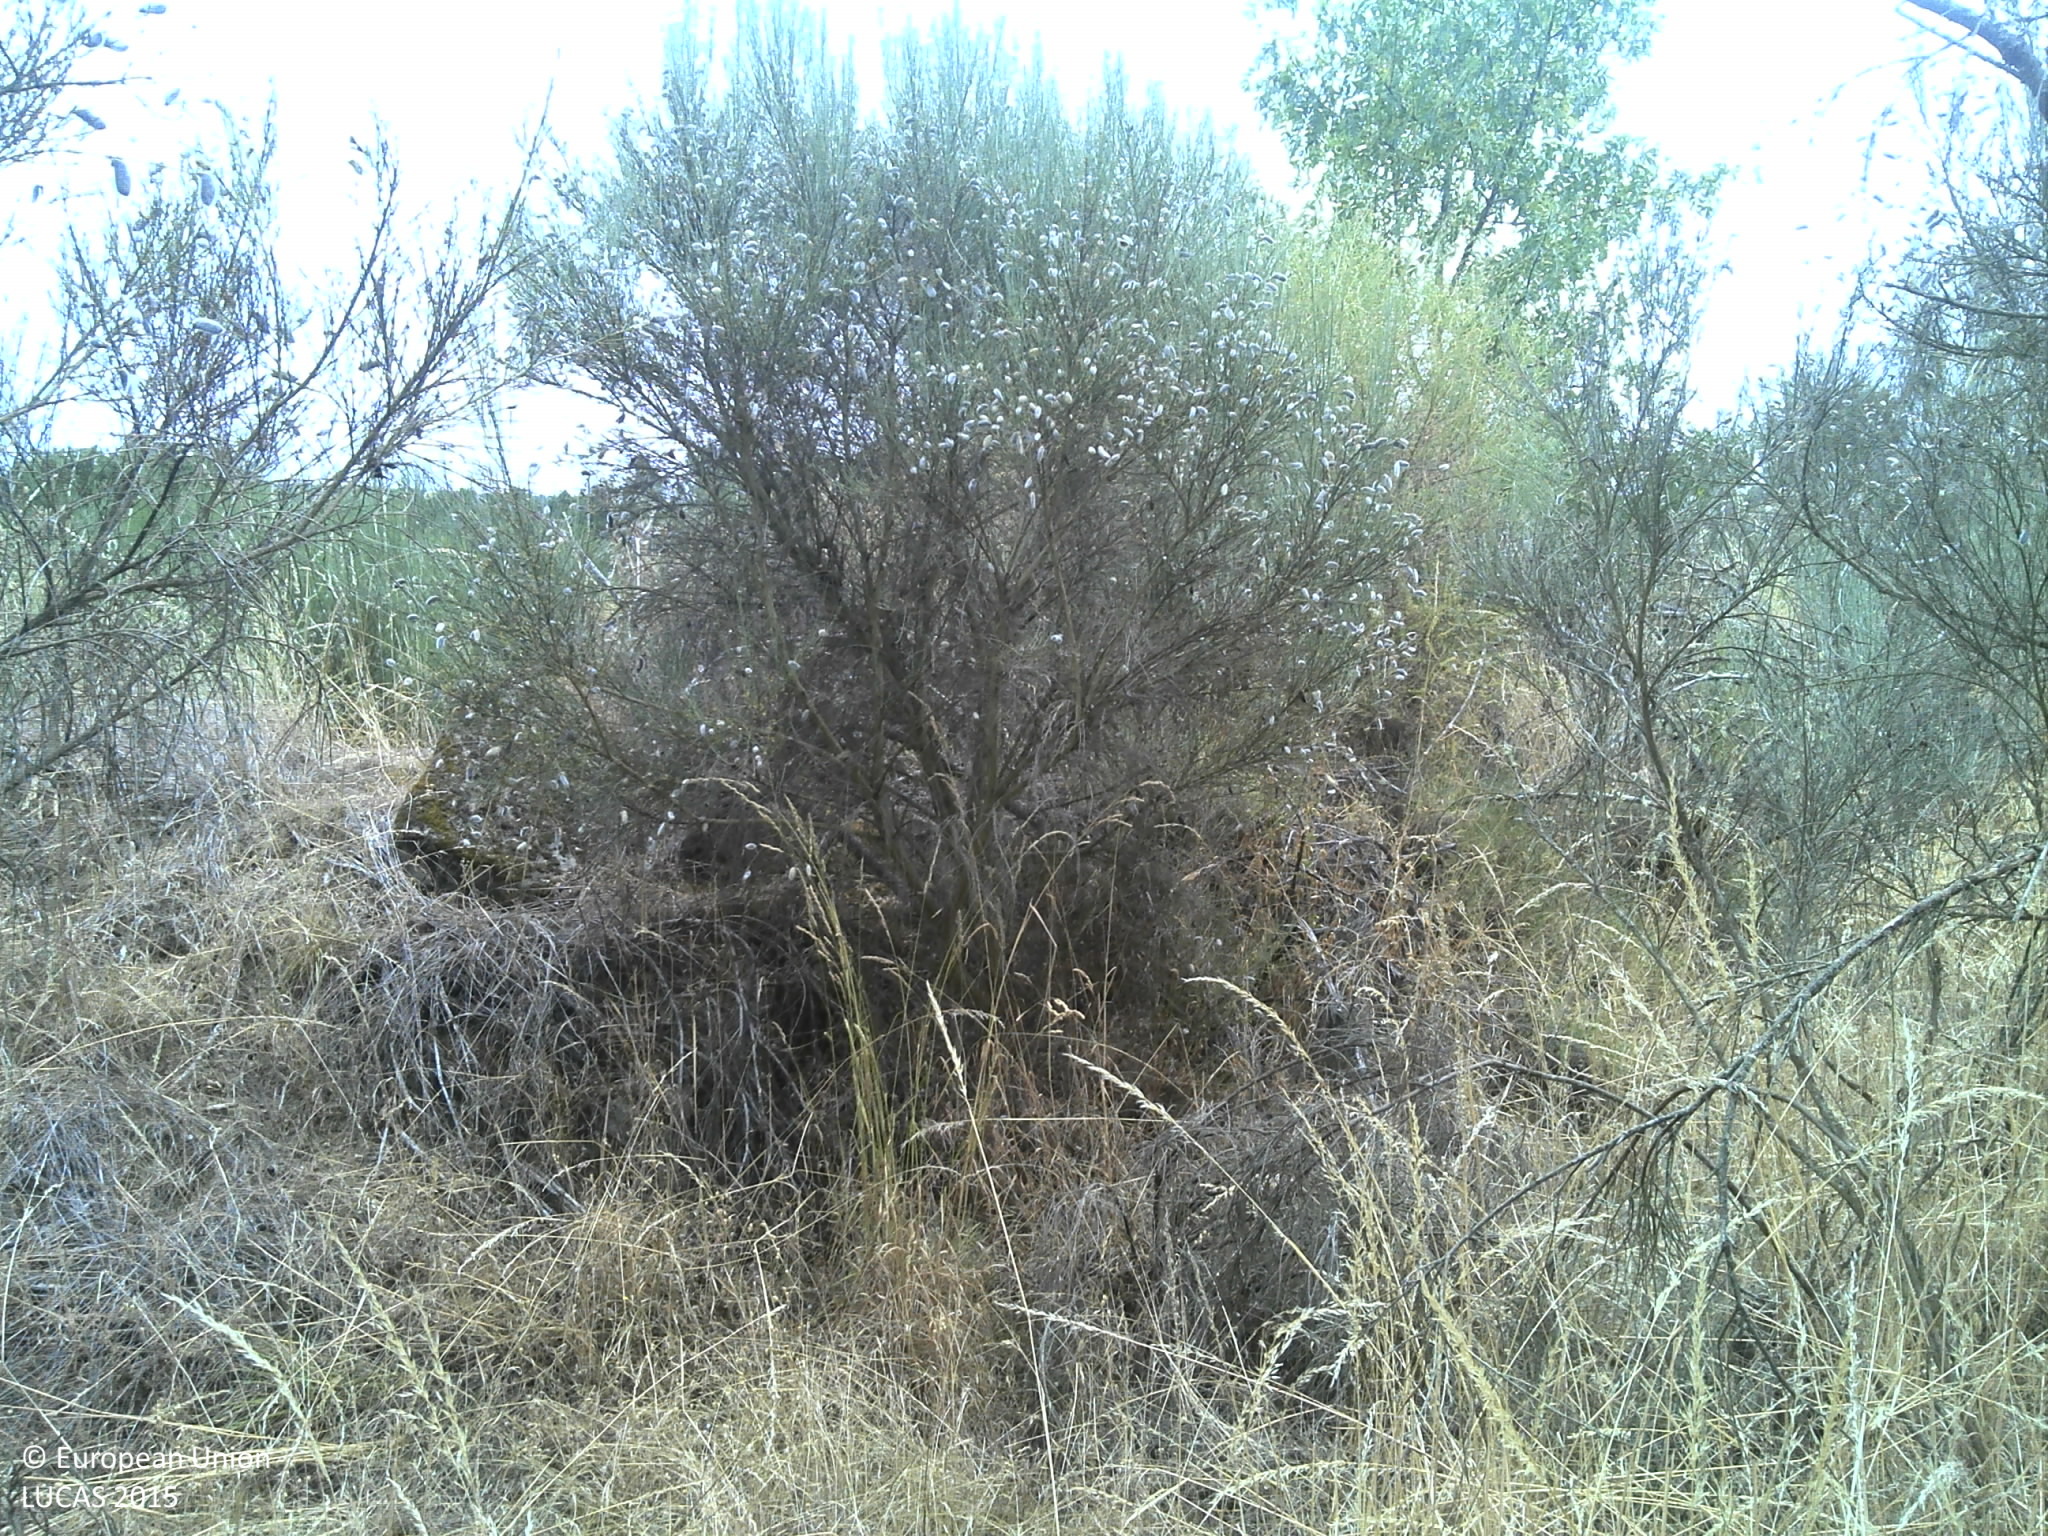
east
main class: Woodland
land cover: Broadleaved woodland
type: mesophytic deciduous forest
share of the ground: 25 - 50 %
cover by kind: shrubs 60 %, broadleaved forest trees 35 %, unconsolidated bare surface 5 %
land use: Semi-natural and natural areas not in use
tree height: > 5 m
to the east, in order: Broadleaved woodland; Shrubland with sparse tree cover; Shrubland without tree cover; Shrubland with sparse tree cover; Pine dominated coniferous woodland; Shrubland with sparse tree cover; Tracks; Shrubland with sparse tree cover; Electric lines; Tracks; Shrubland without tree cover; Shrubland with sparse tree cover; Electric lines; Pine dominated coniferous woodland; Shrubland with sparse tree cover
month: July
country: PT
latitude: 40.9756
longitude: -7.3591
